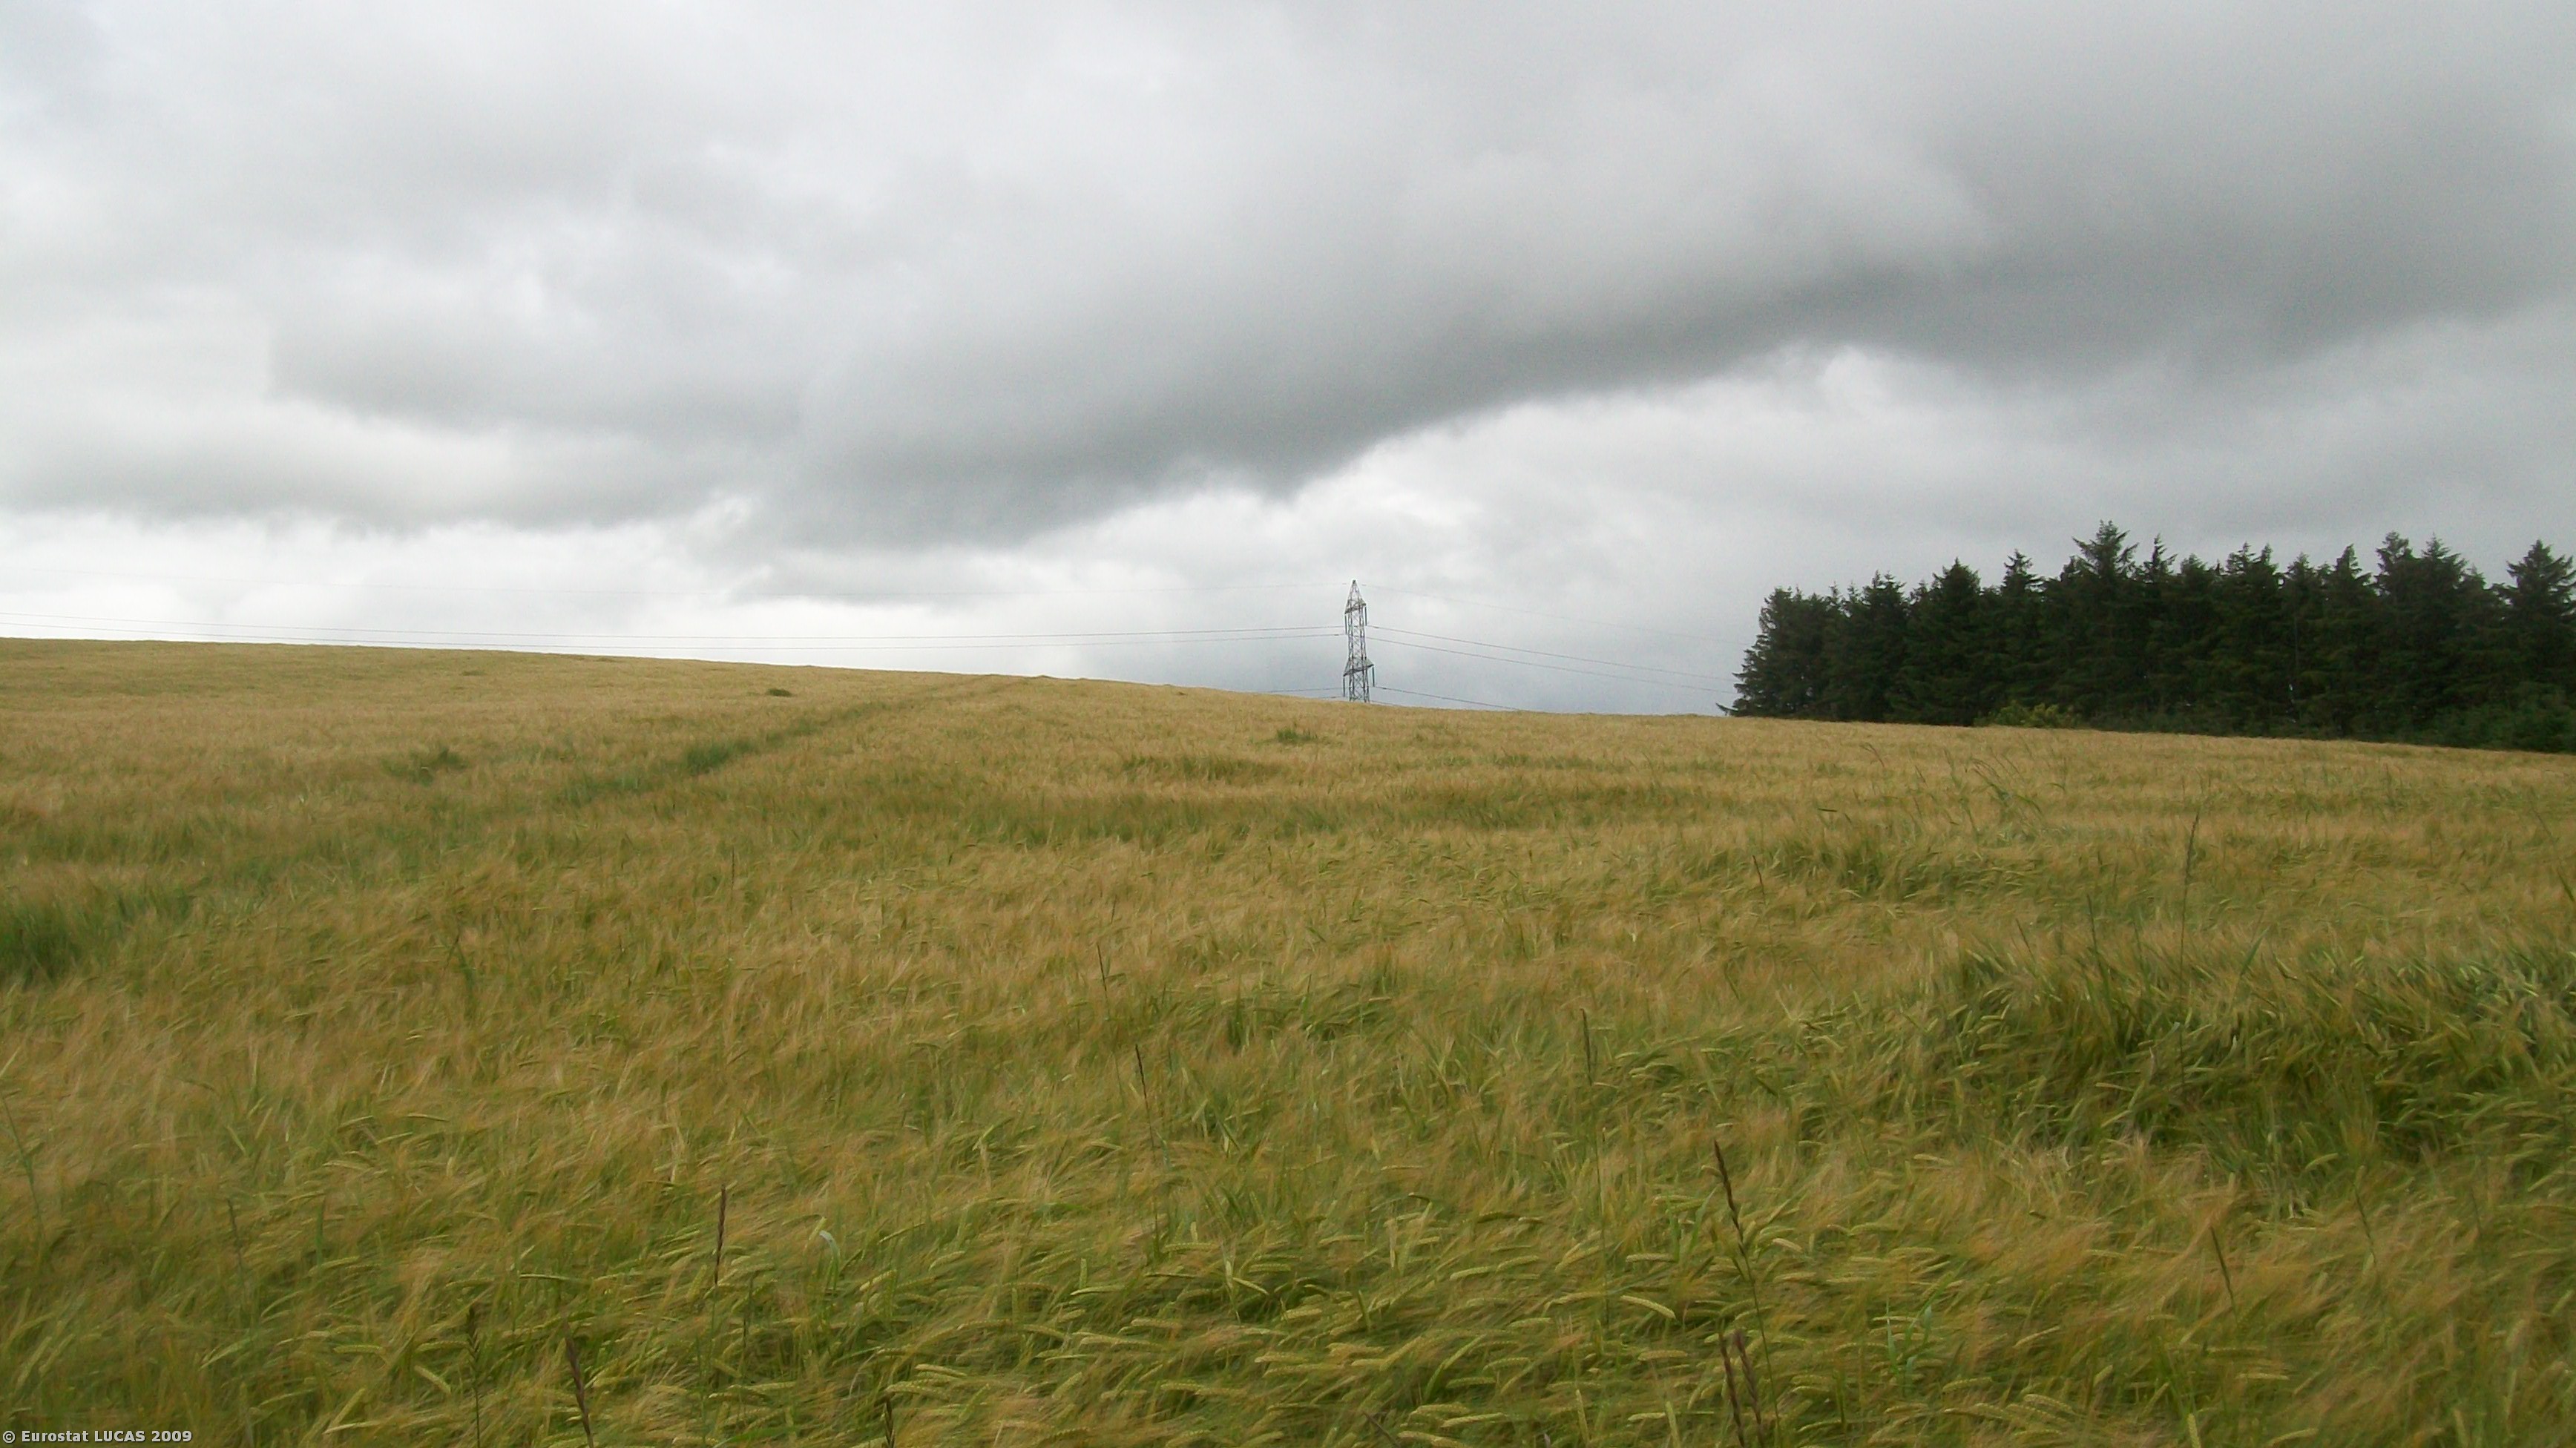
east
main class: Cropland
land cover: Barley
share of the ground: > 75 %
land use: Agriculture (excluding fallow land and kitchen gardens)
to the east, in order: Barley
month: July
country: GB
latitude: 57.4443
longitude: -2.5671
